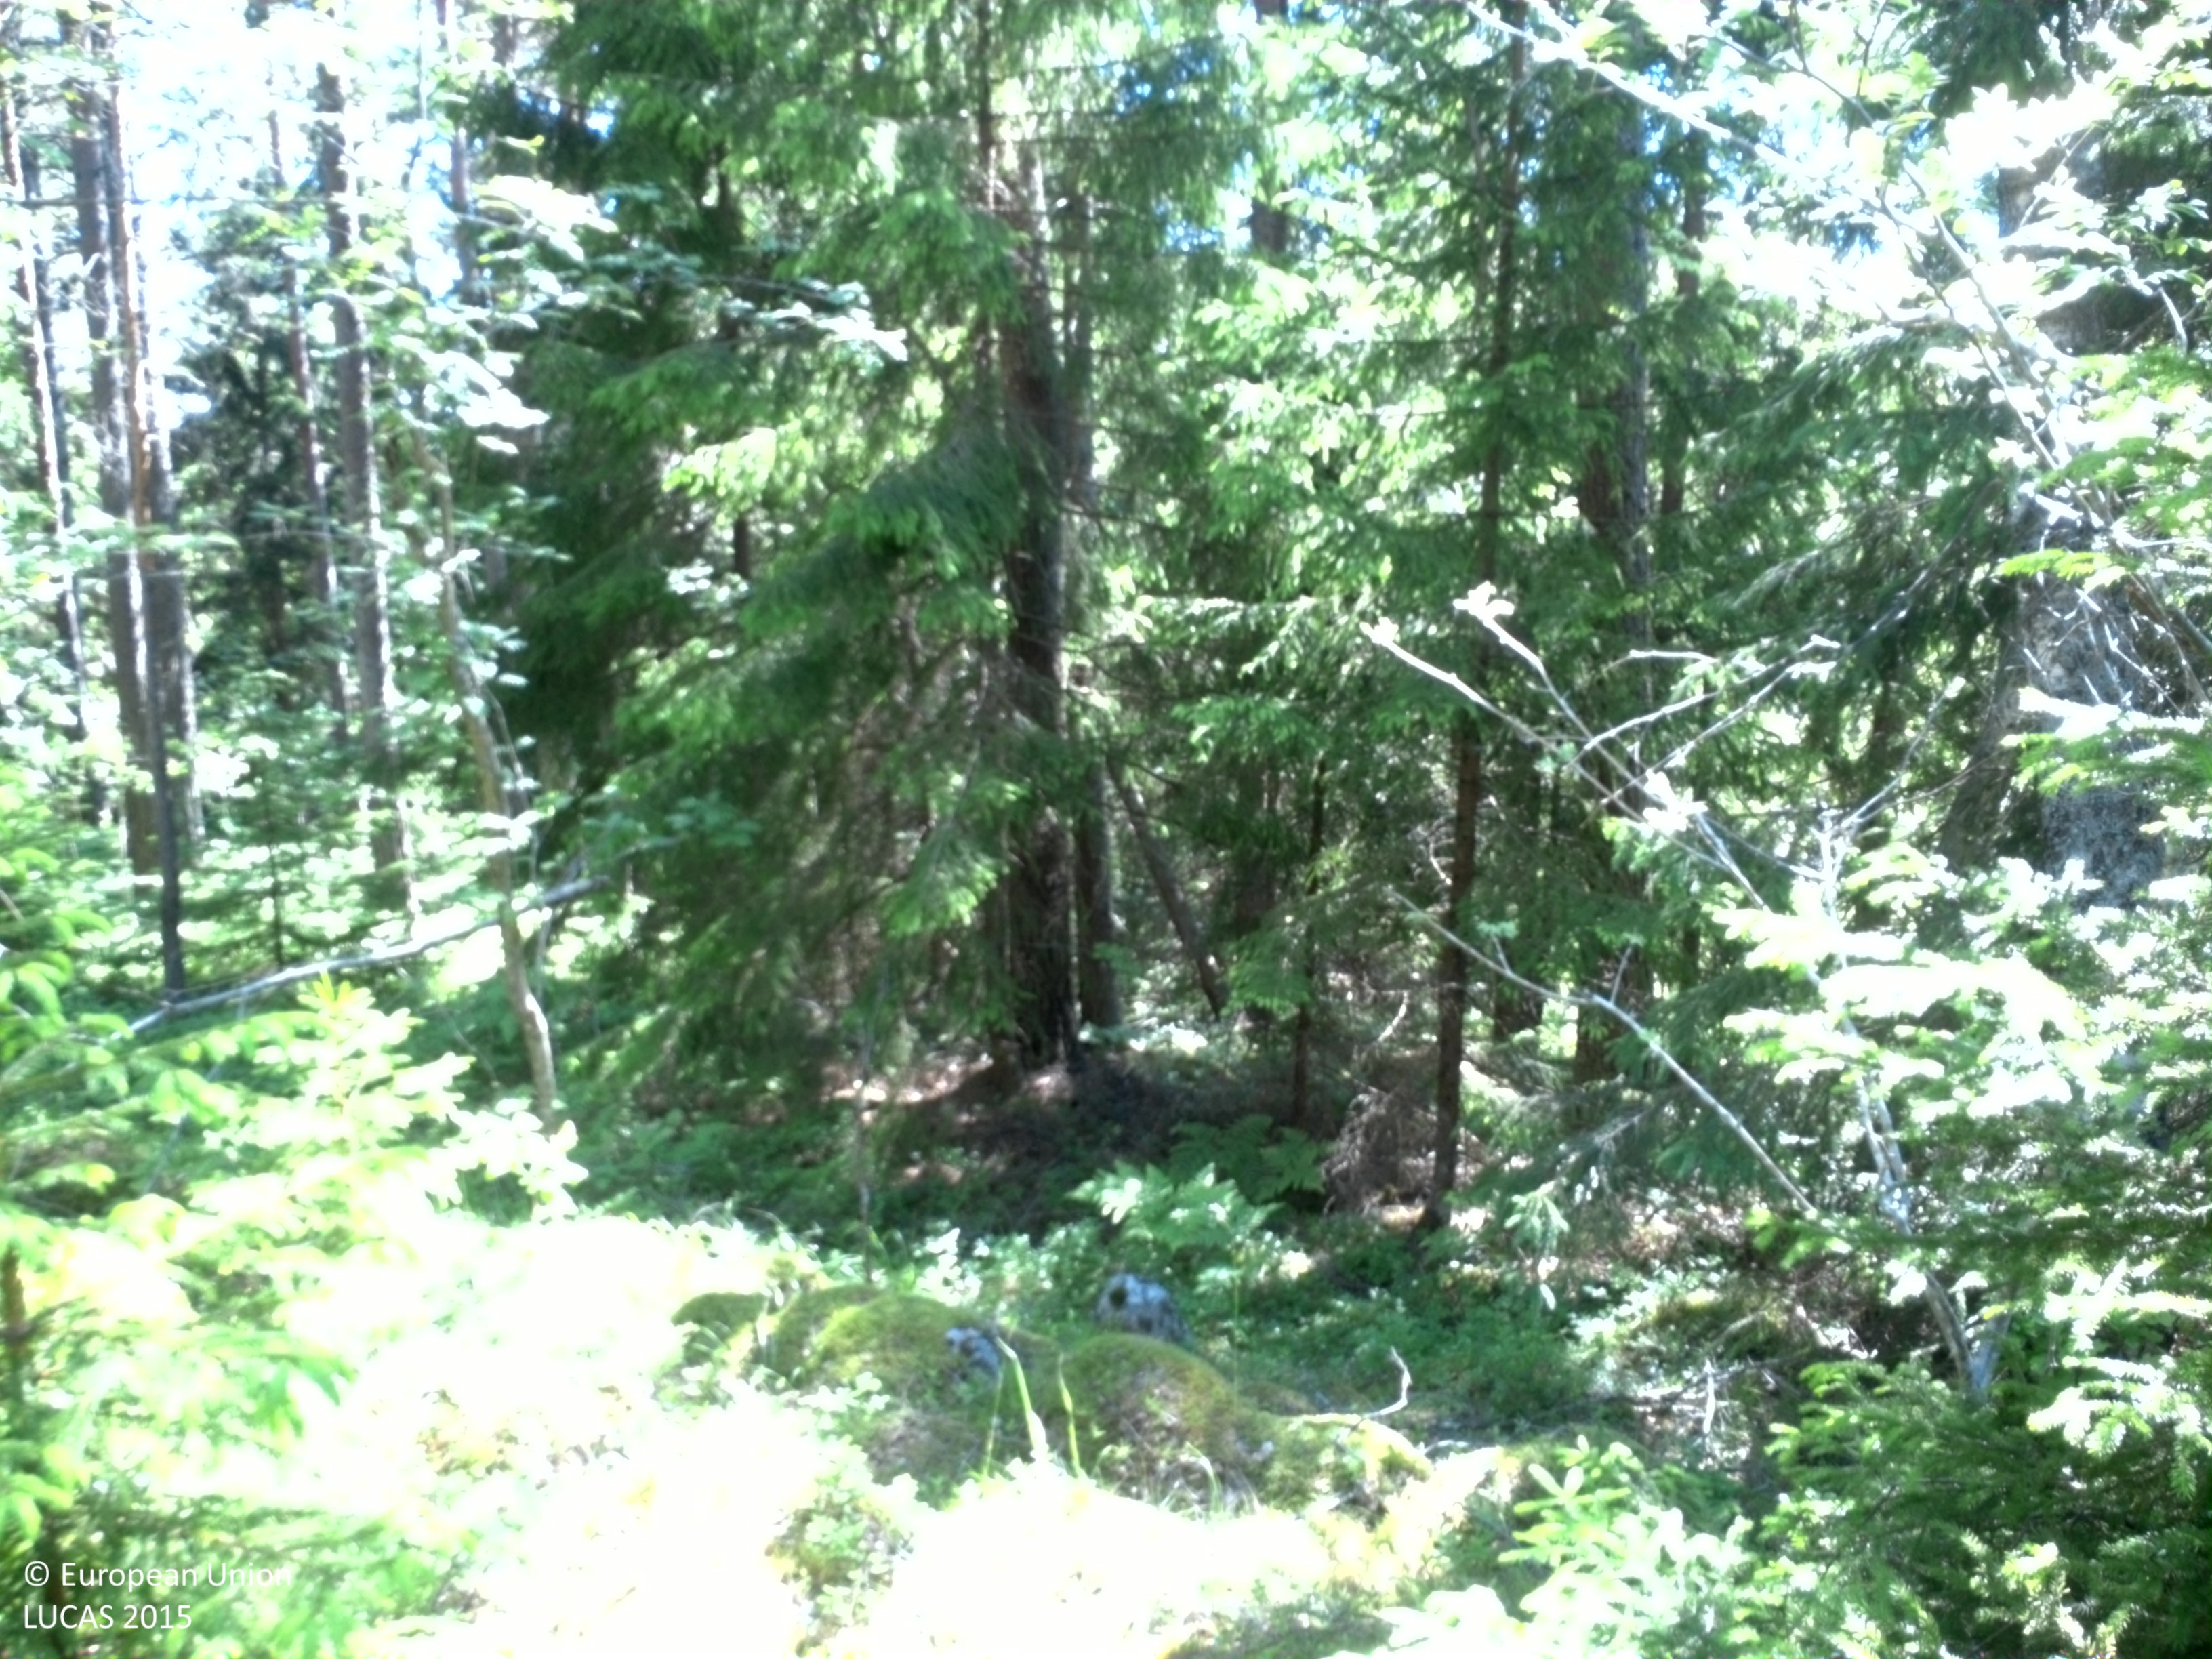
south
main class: Woodland
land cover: Pine dominated mixed woodland
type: boreal forest
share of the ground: 25 - 50 %
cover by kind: herbaceous plants 45 %, coniferous forest trees 20 %, lichens and mosses 20 %, broadleaved forest trees 10 %, shrubs 5 %
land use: Forestry
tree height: > 5 m
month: June
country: SE
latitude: 58.5656
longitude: 15.3059
